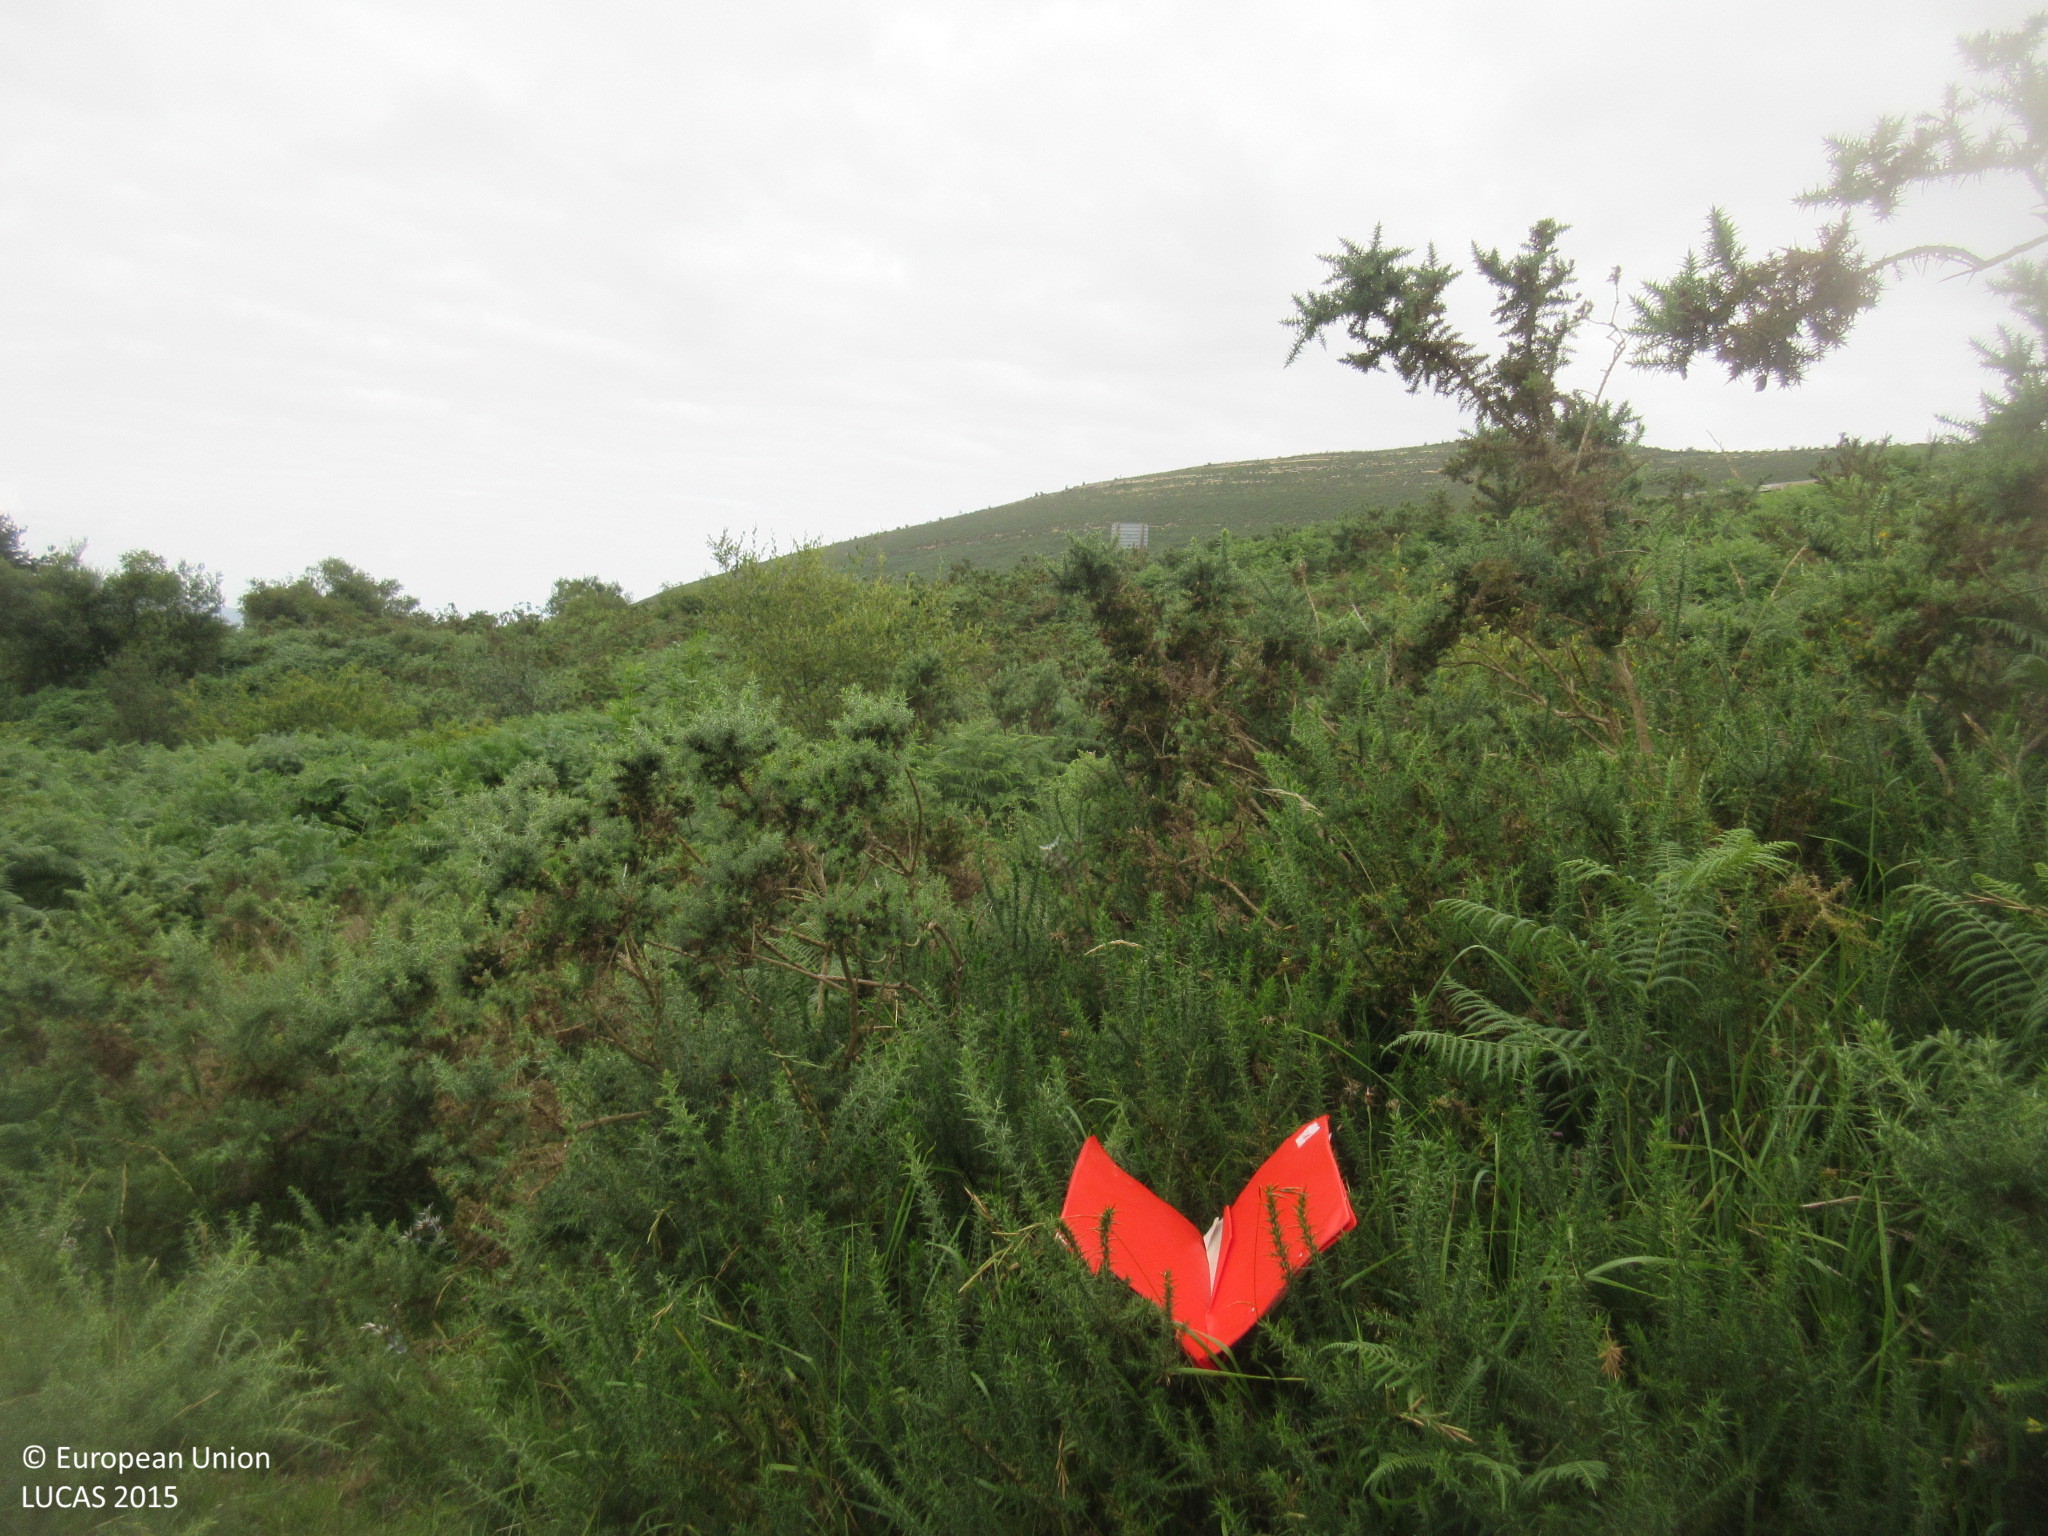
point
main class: Shrubland
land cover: Shrubland without tree cover
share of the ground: 50 - 75 %
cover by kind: shrubs 70 %, herbaceous plants 30 %
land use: Agriculture (excluding fallow land and kitchen gardens)
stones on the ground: < 10 %
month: July
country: ES
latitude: 43.3007
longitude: -4.4191
